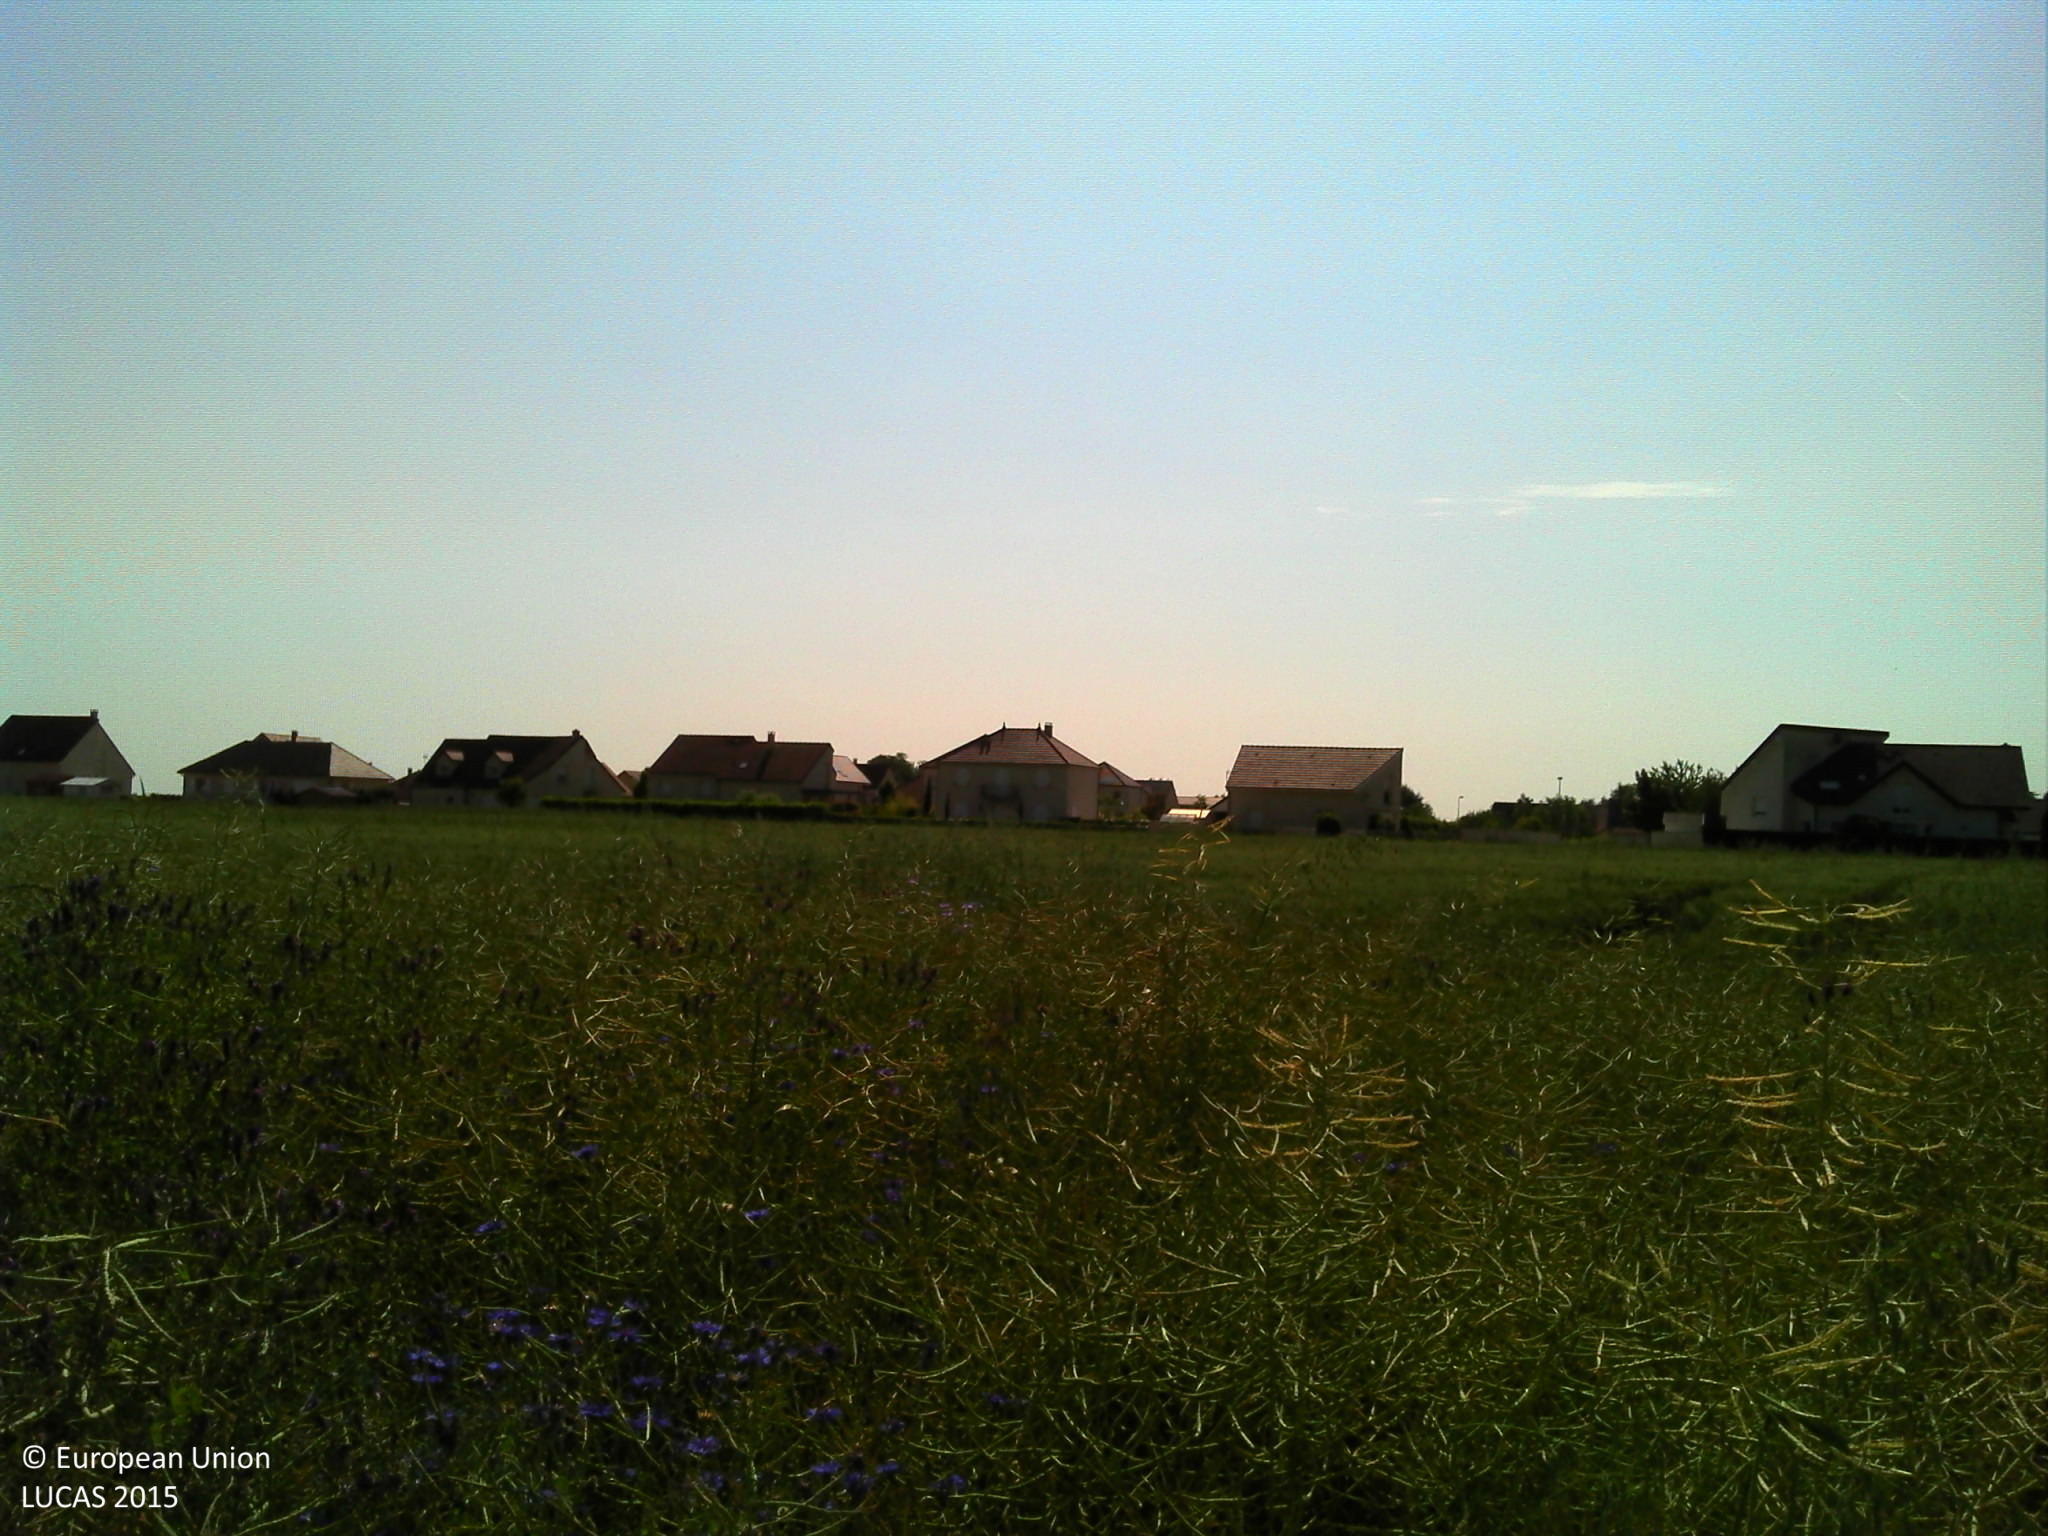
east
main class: Cropland
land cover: Rape and turnip rape
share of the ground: > 75 %
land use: Agriculture (excluding fallow land and kitchen gardens)
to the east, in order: Rape and turnip rape; Common wheat; Barley
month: June
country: FR
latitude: 47.2647
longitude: 5.0445
